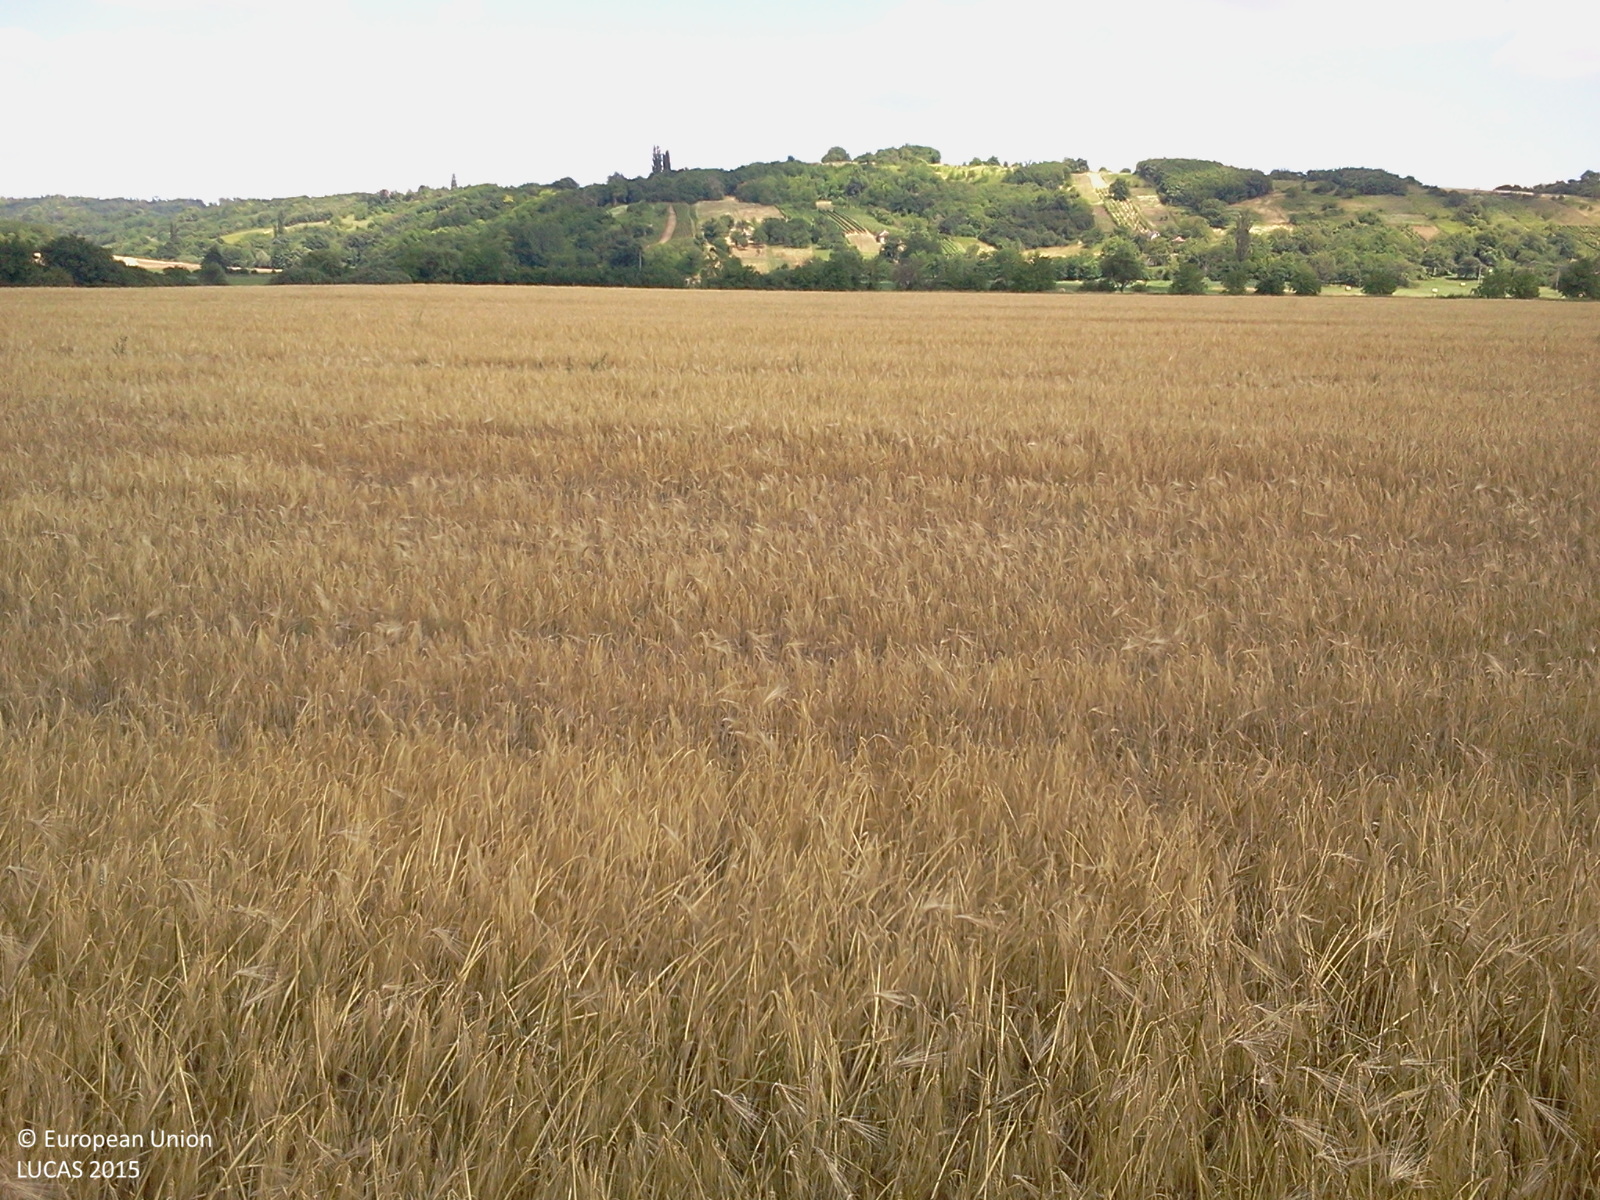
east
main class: Cropland
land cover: Barley
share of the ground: > 75 %
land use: Agriculture (excluding fallow land and kitchen gardens)
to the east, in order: Barley
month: June
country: HU
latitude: 46.9279
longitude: 17.1098
